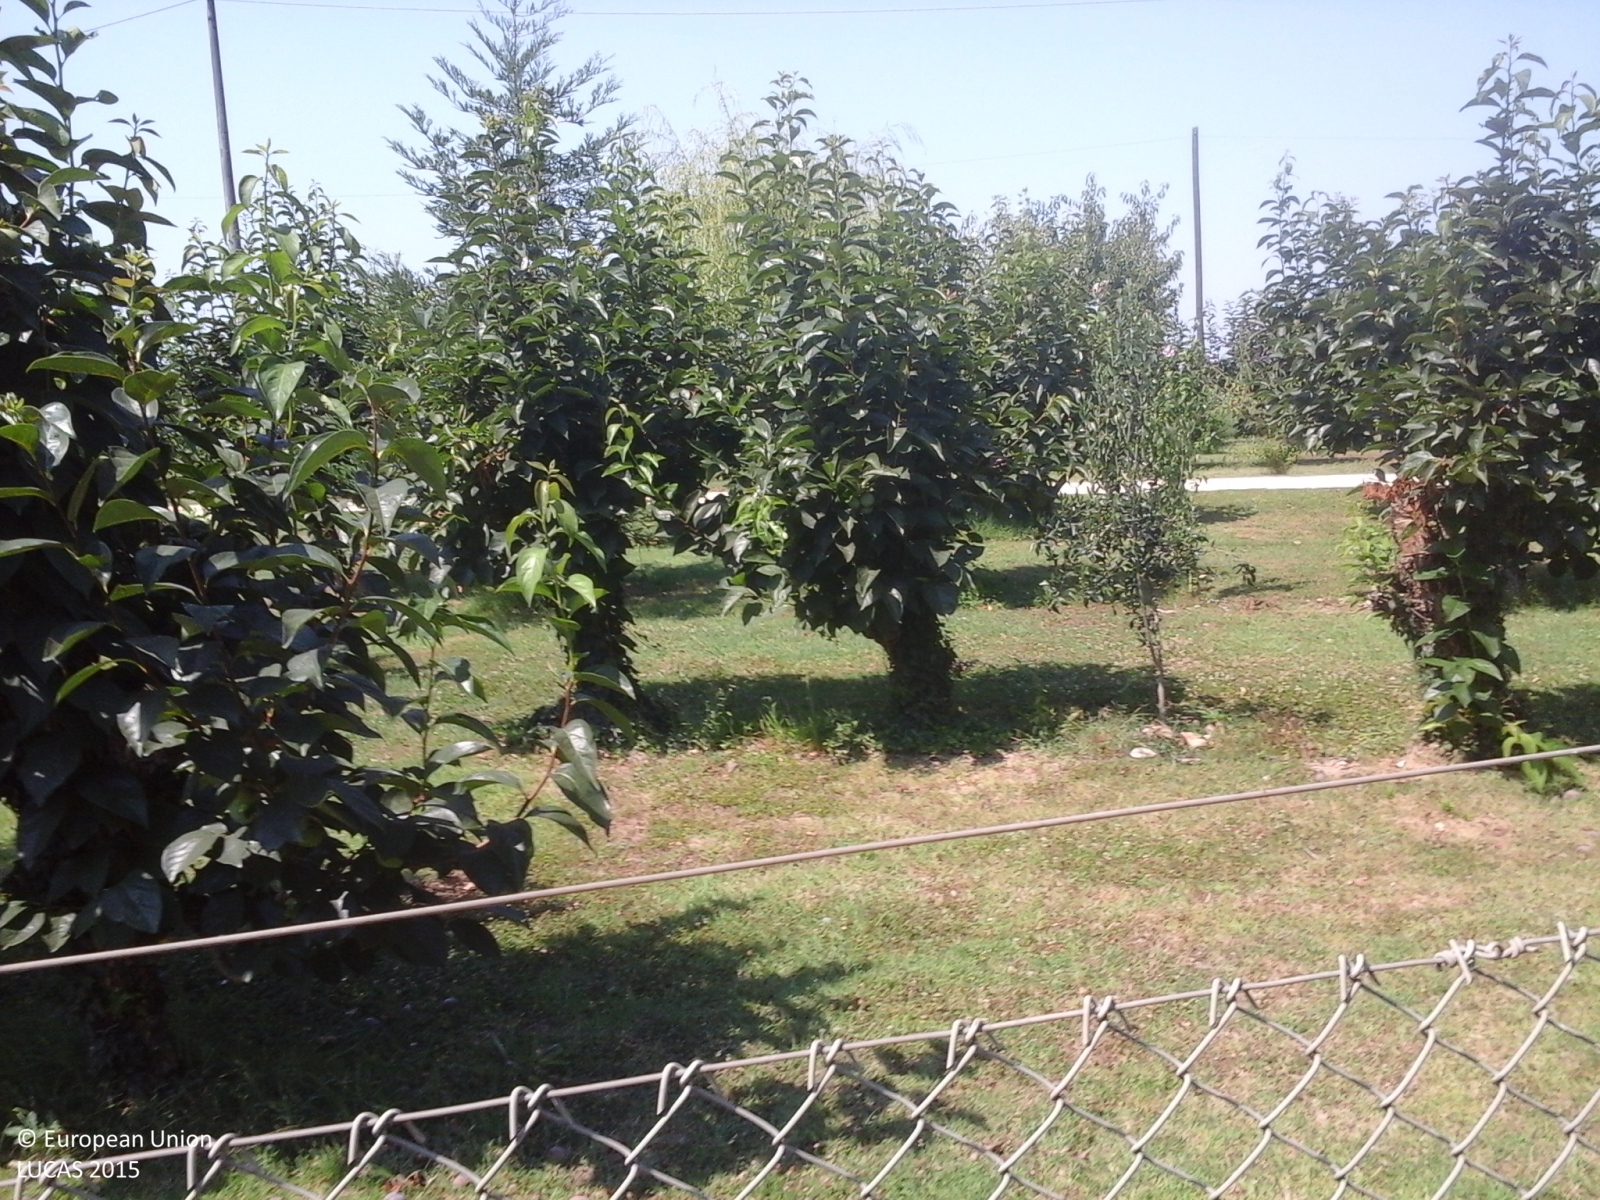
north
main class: Cropland
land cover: Other fruit trees and berries
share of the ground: > 75 %
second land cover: Grassland without tree/shrub cover
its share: > 75 %
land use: Kitchen garden
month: July
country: IT
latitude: 44.4776
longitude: 11.8943
